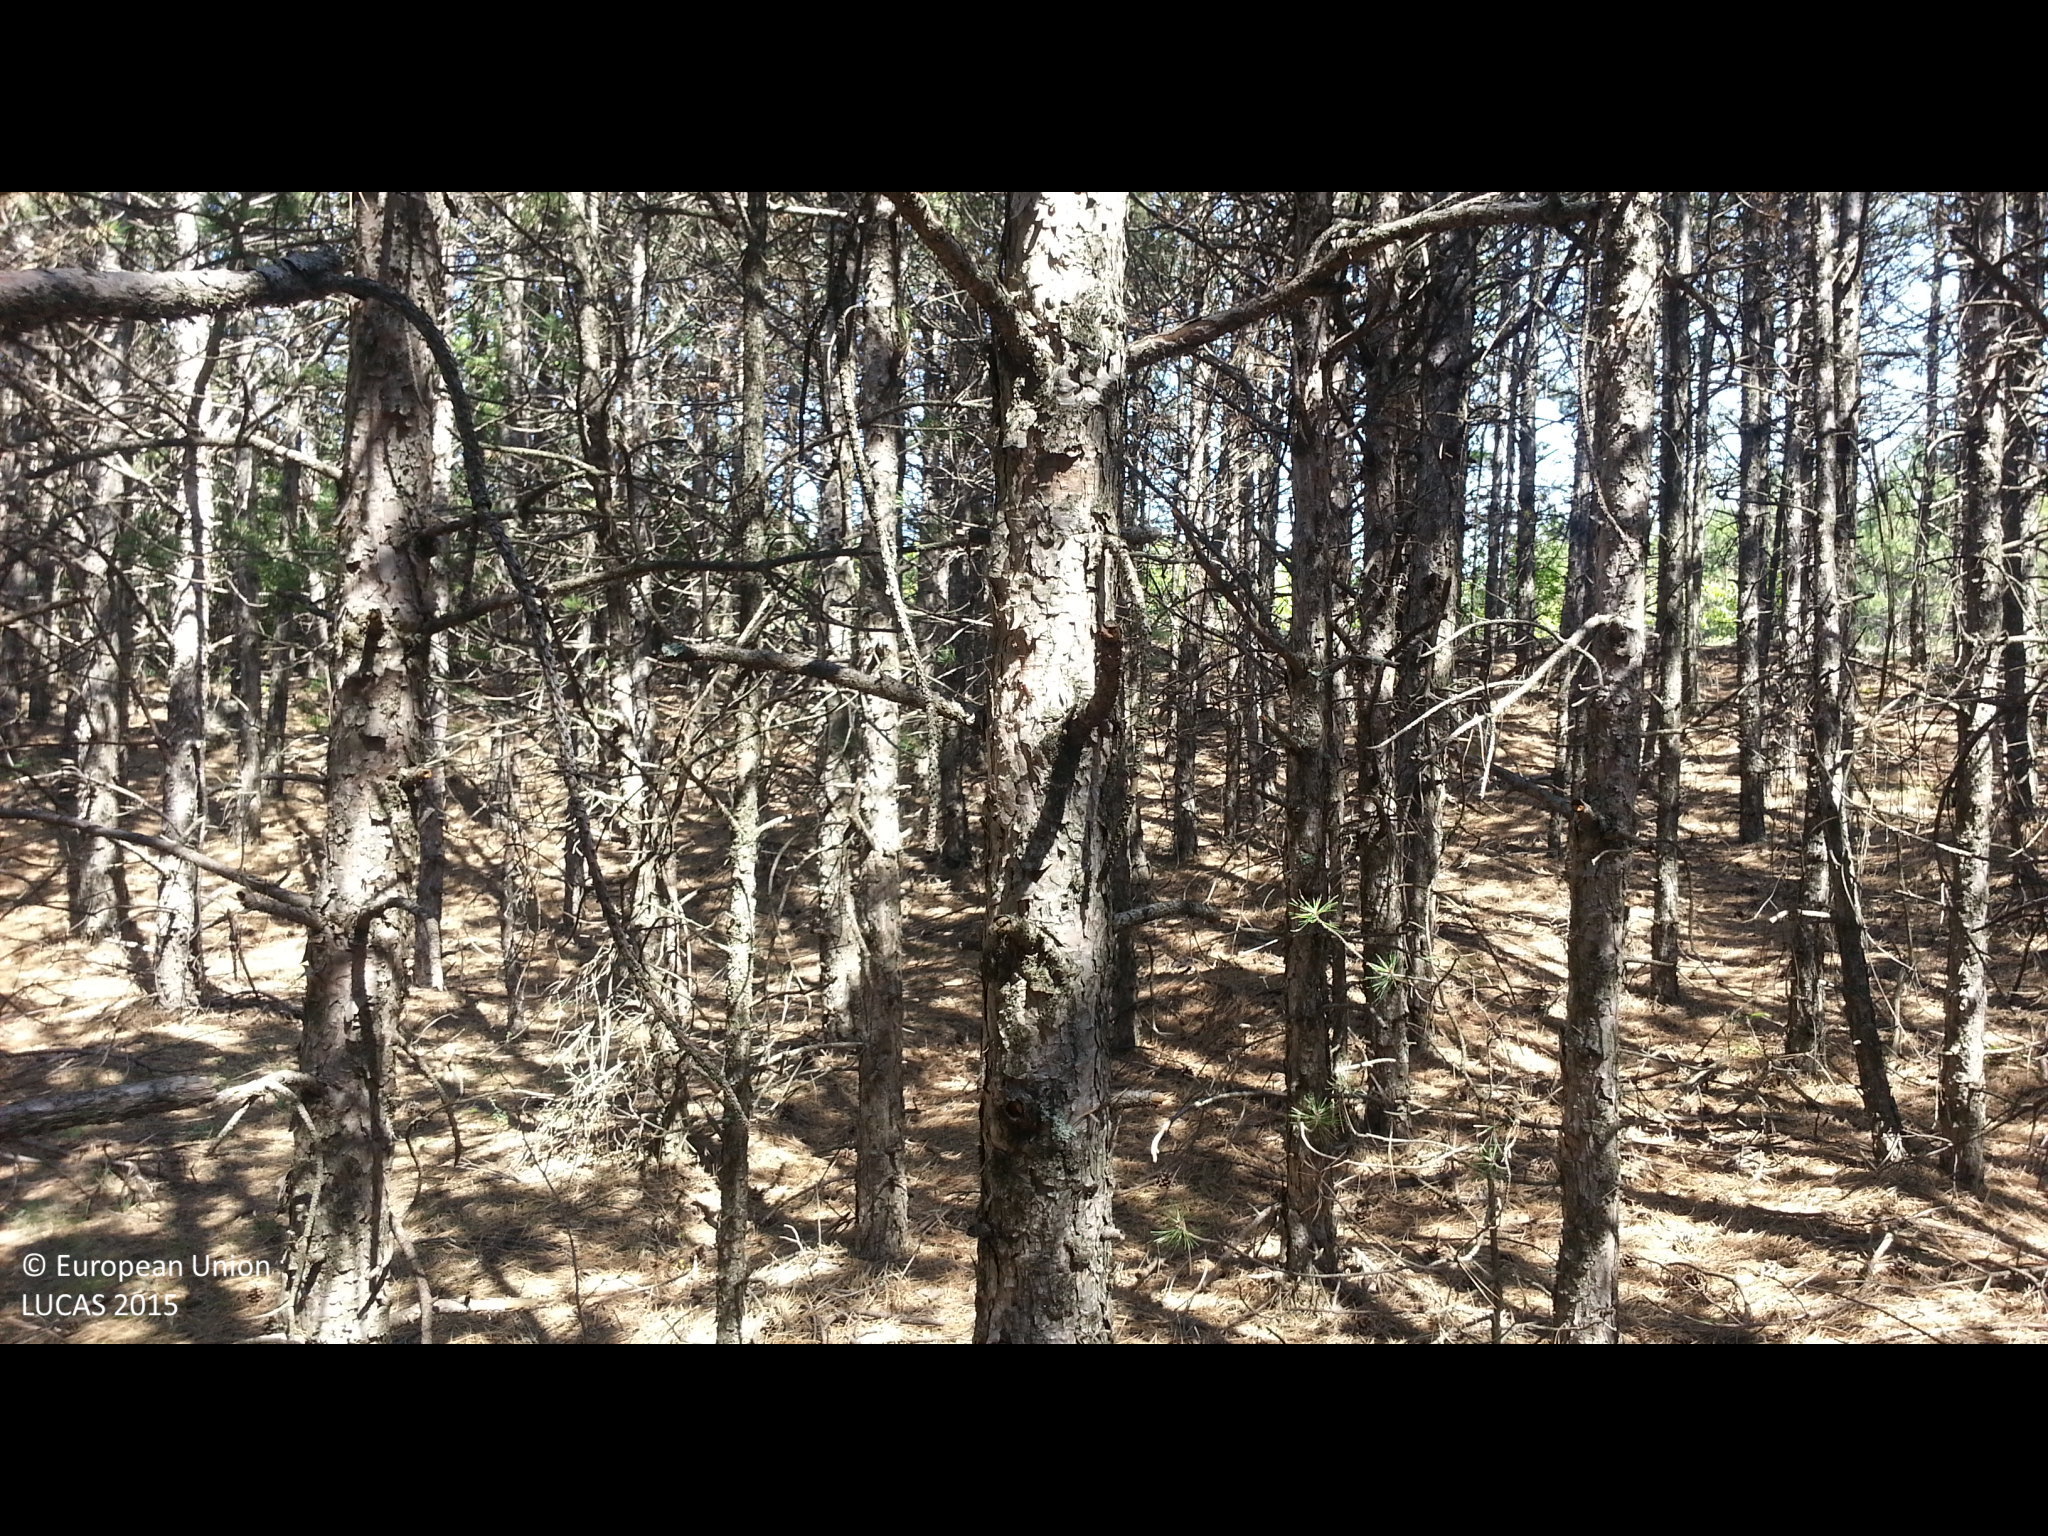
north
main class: Woodland
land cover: Pine dominated coniferous woodland
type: hemiboreal forest and nemoral coniferous forest and mixed broadleaved-coniferous forest
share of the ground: > 75 %
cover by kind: coniferous forest trees 100 %
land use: Forestry
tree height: > 5 m
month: August
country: BG
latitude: 42.5069
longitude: 23.1367
